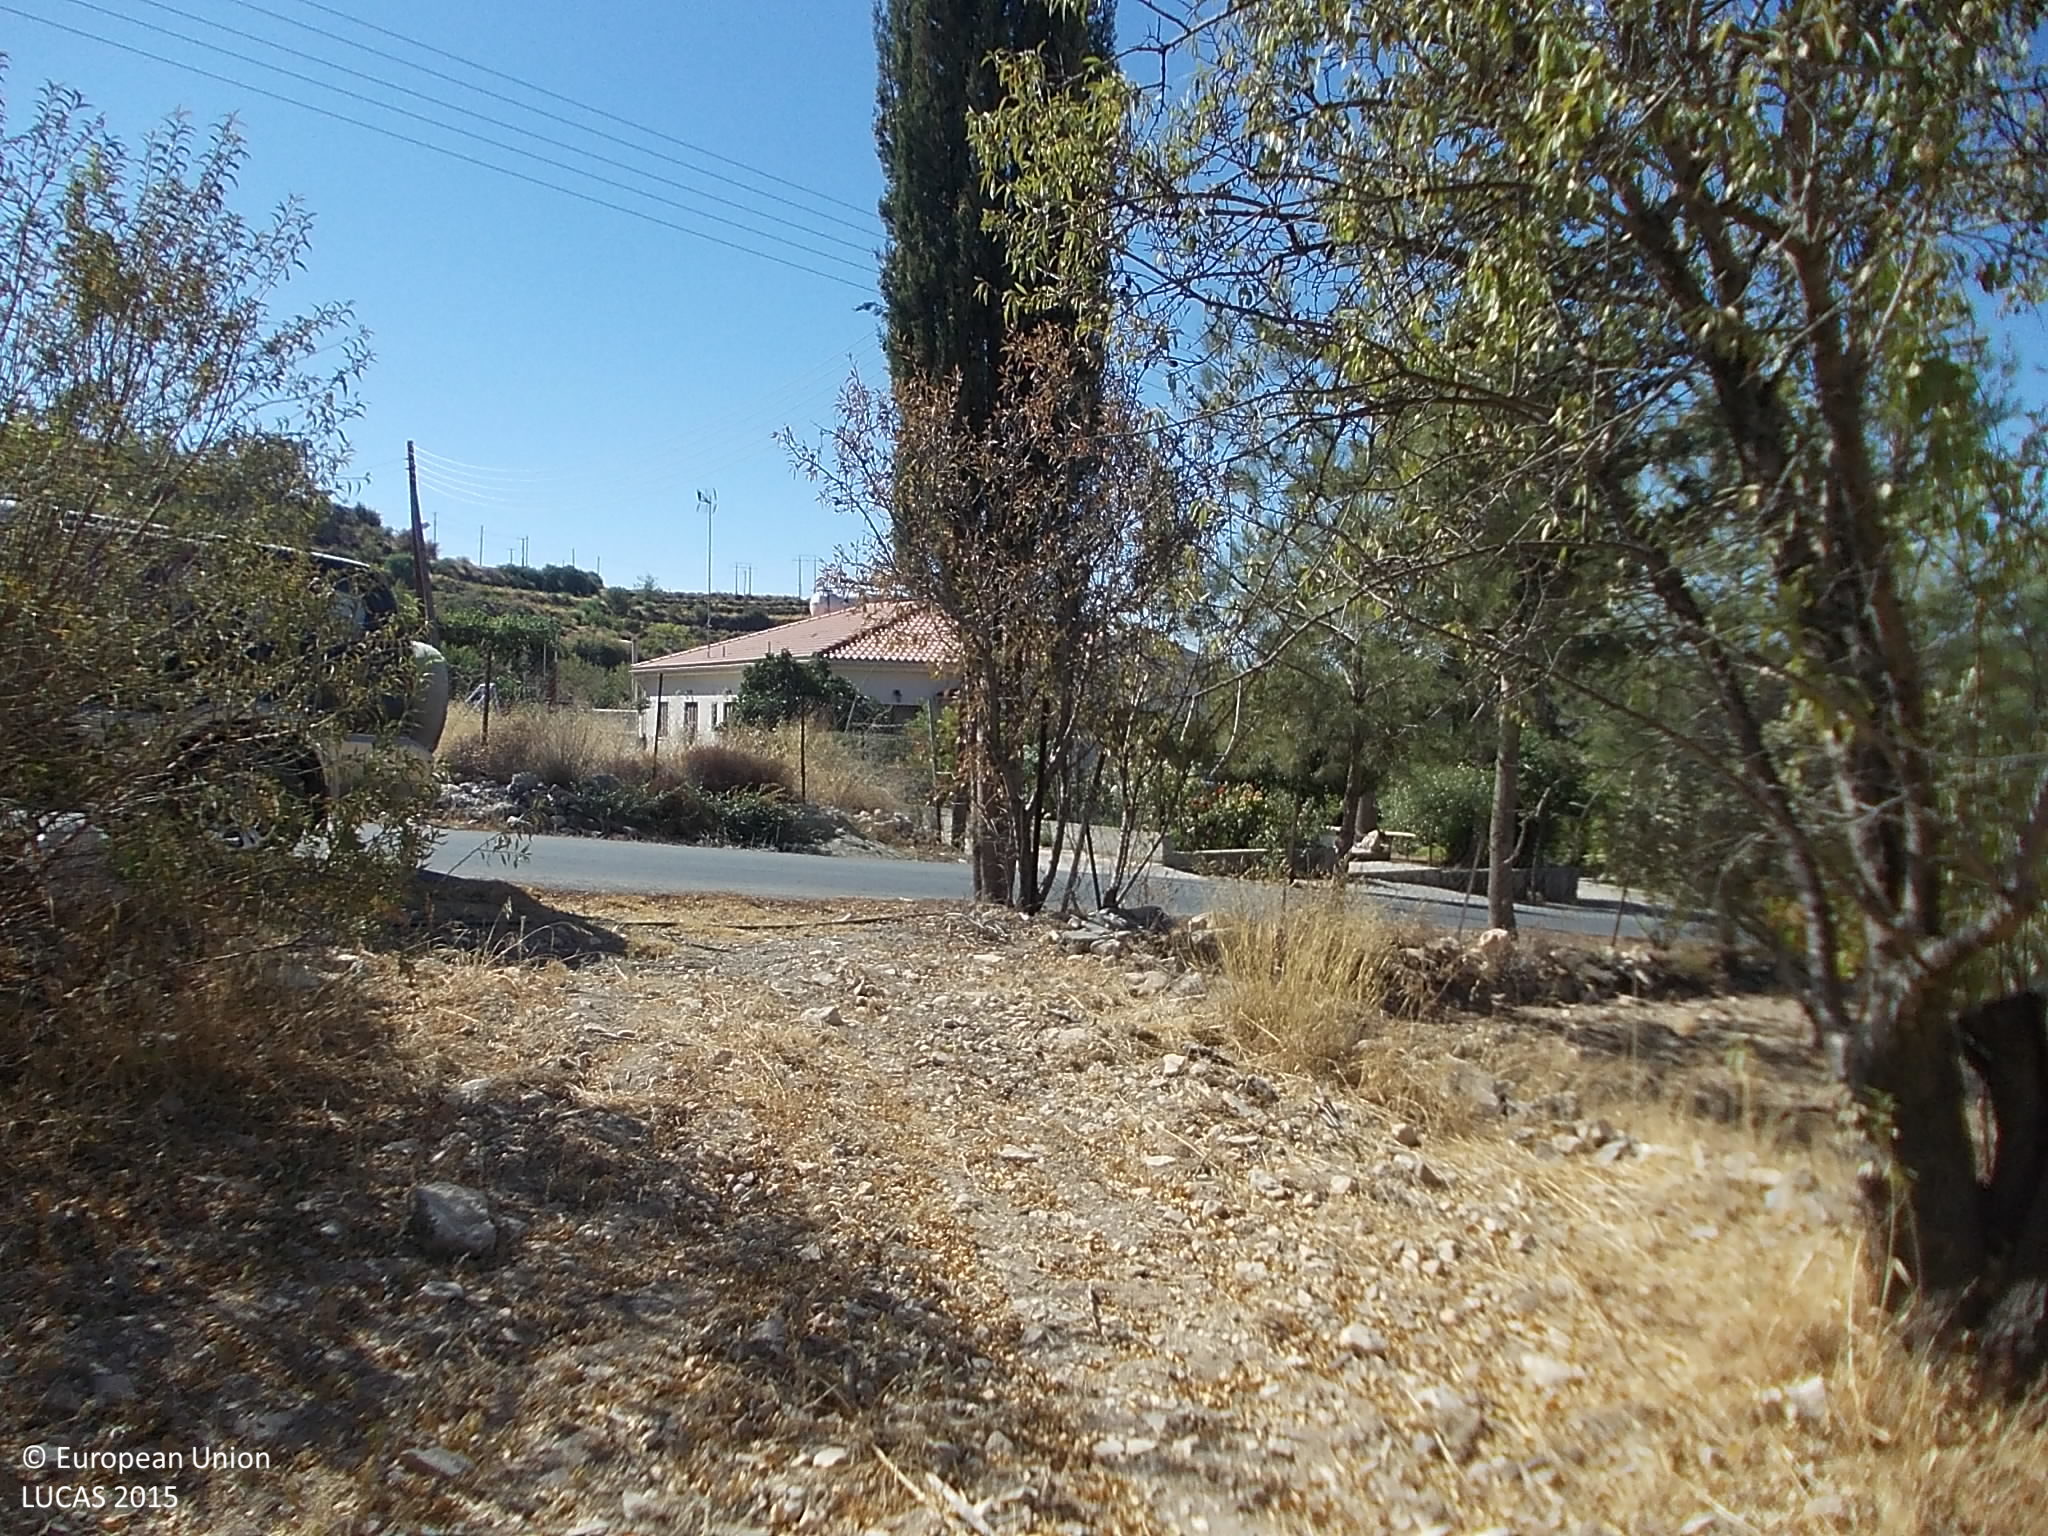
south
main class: Cropland
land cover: Nuts trees
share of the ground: 25 - 50 %
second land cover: Olive groves
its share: < 10 %
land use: Agriculture (excluding fallow land and kitchen gardens)
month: June
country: CY
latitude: 34.8158
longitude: 32.9145
